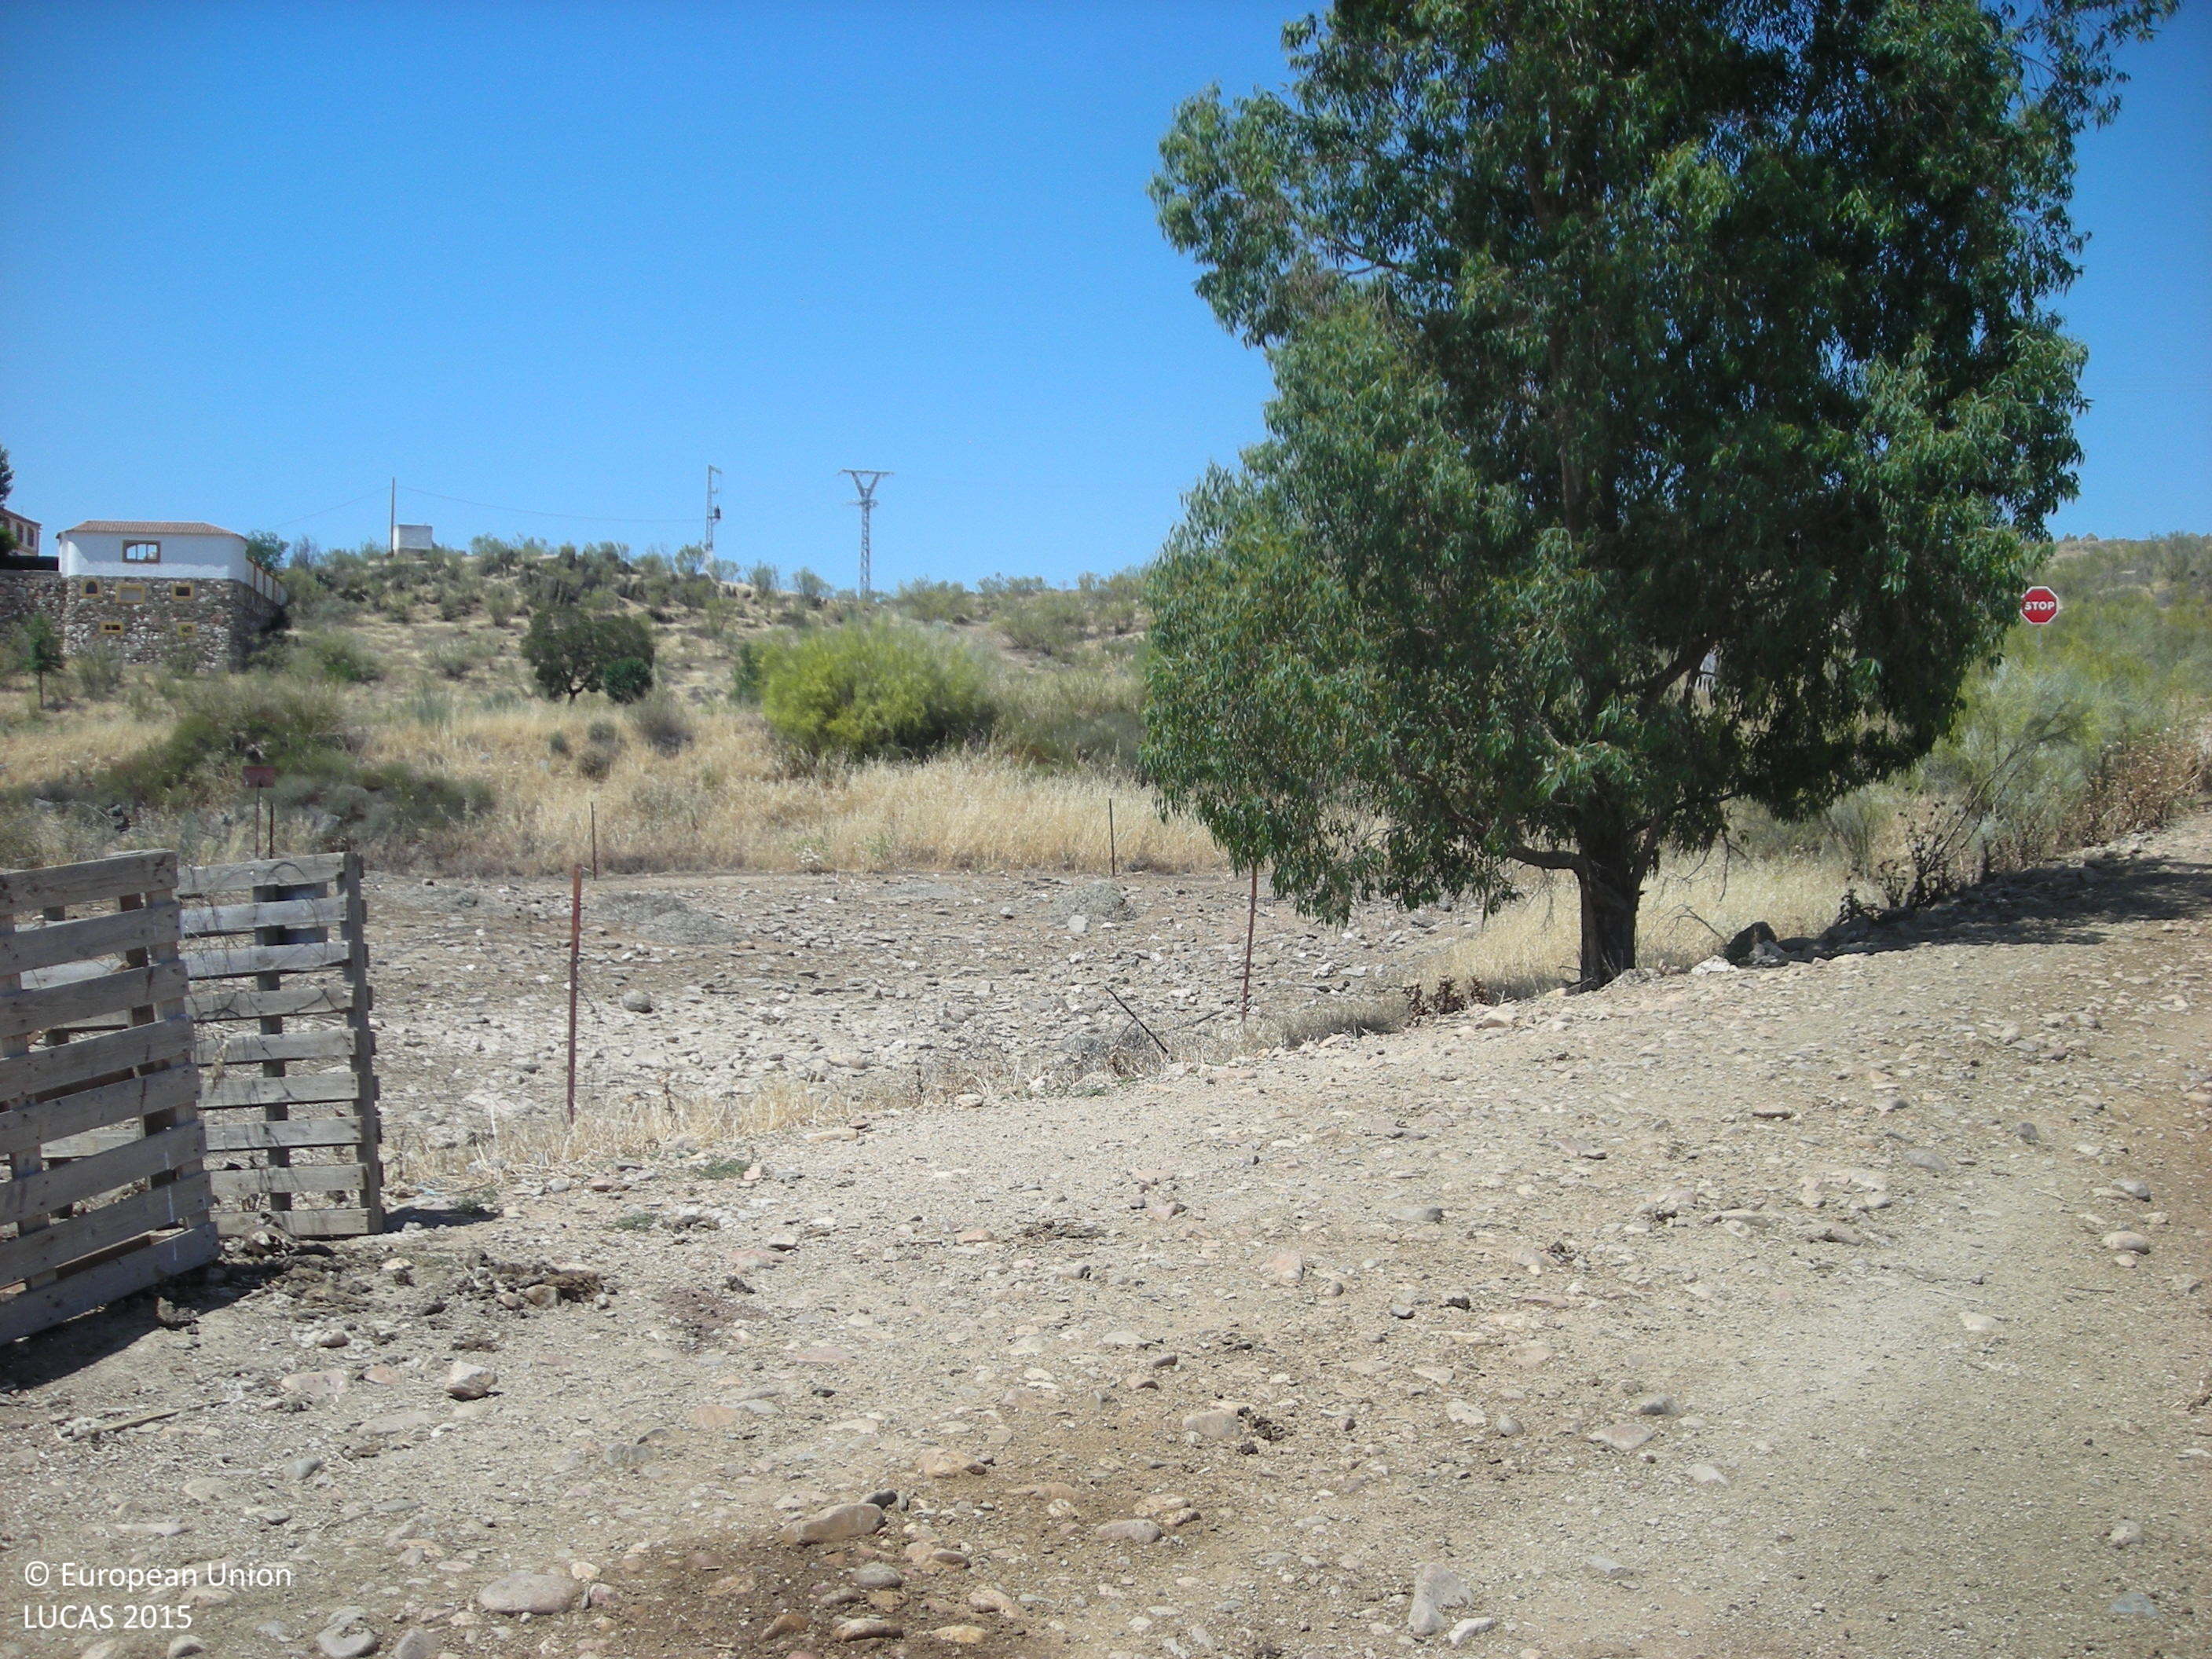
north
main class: Cropland
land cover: Mixed cereals for fodder
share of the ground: > 75 %
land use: Agriculture (excluding fallow land and kitchen gardens)
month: June
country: ES
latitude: 38.9191
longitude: -5.4856
